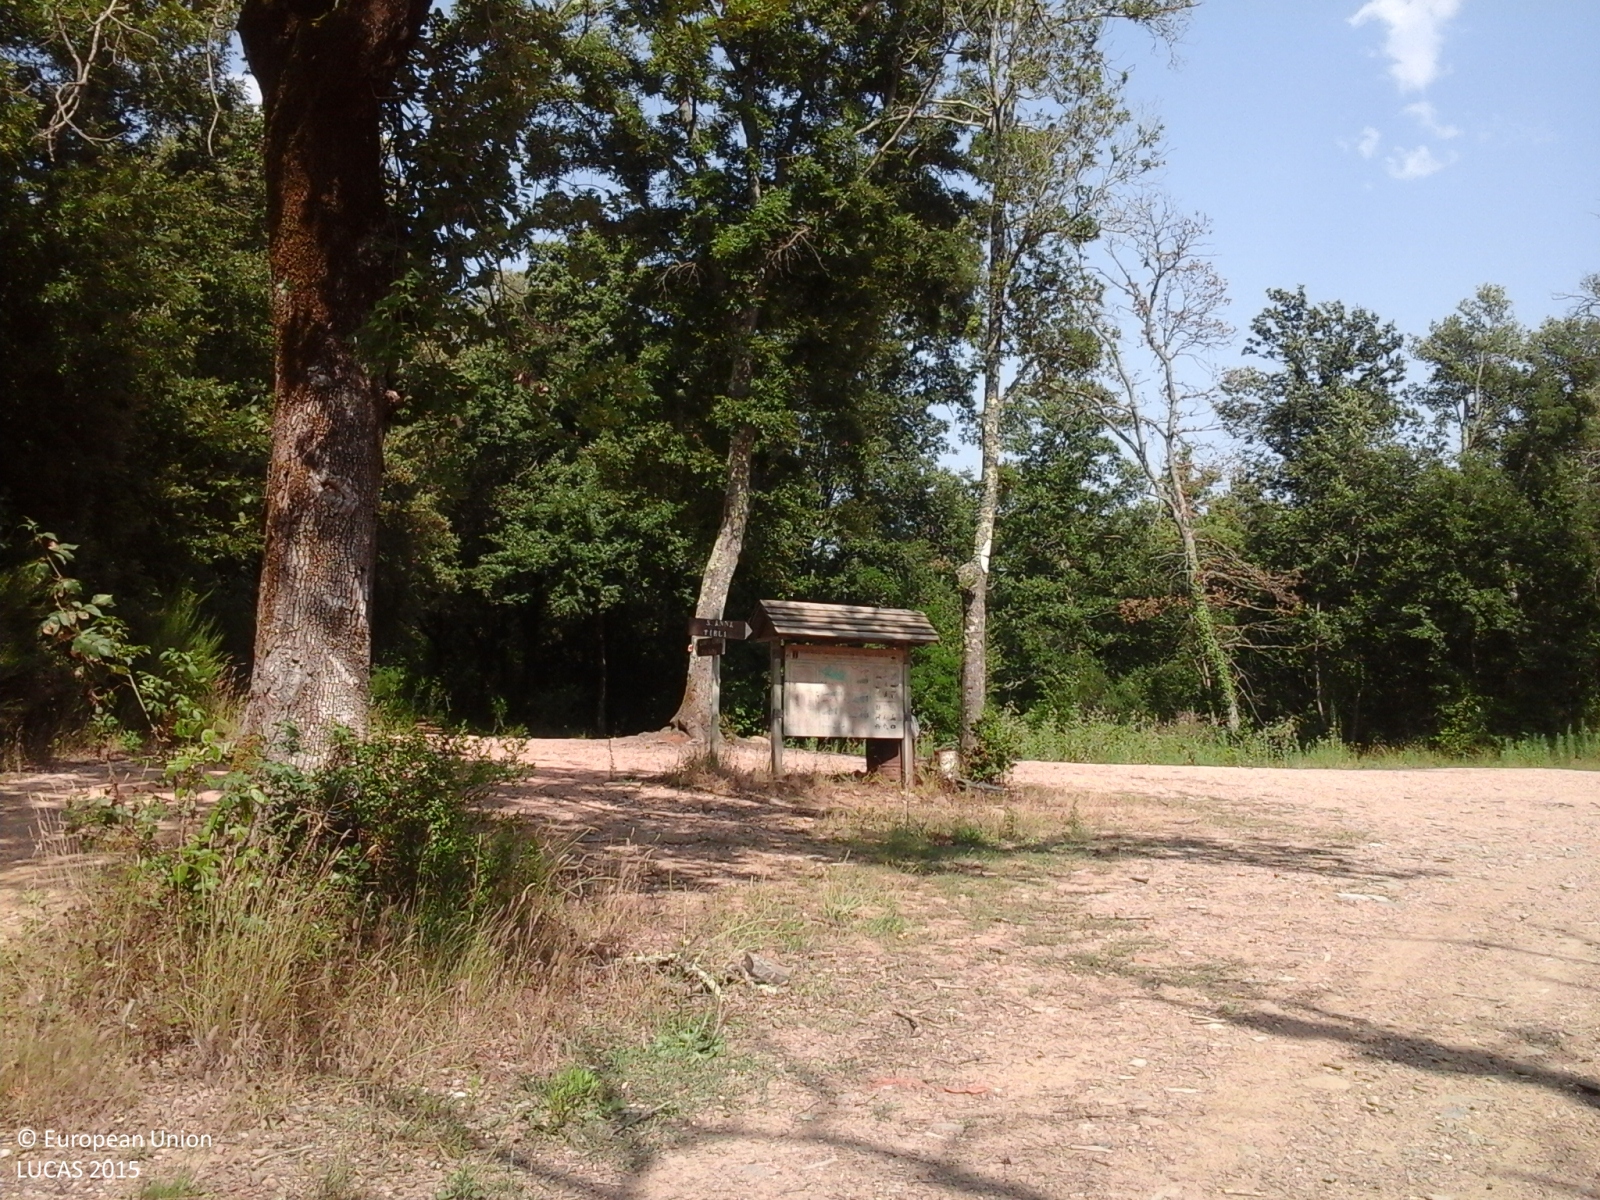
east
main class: Woodland
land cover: Broadleaved woodland
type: broadleaved evergreen forest
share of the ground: > 75 %
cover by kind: broadleaved forest trees 100 %
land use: Forestry
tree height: > 5 m
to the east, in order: Broadleaved woodland; Tracks; Broadleaved woodland
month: July
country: IT
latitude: 42.8668
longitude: 10.8907
